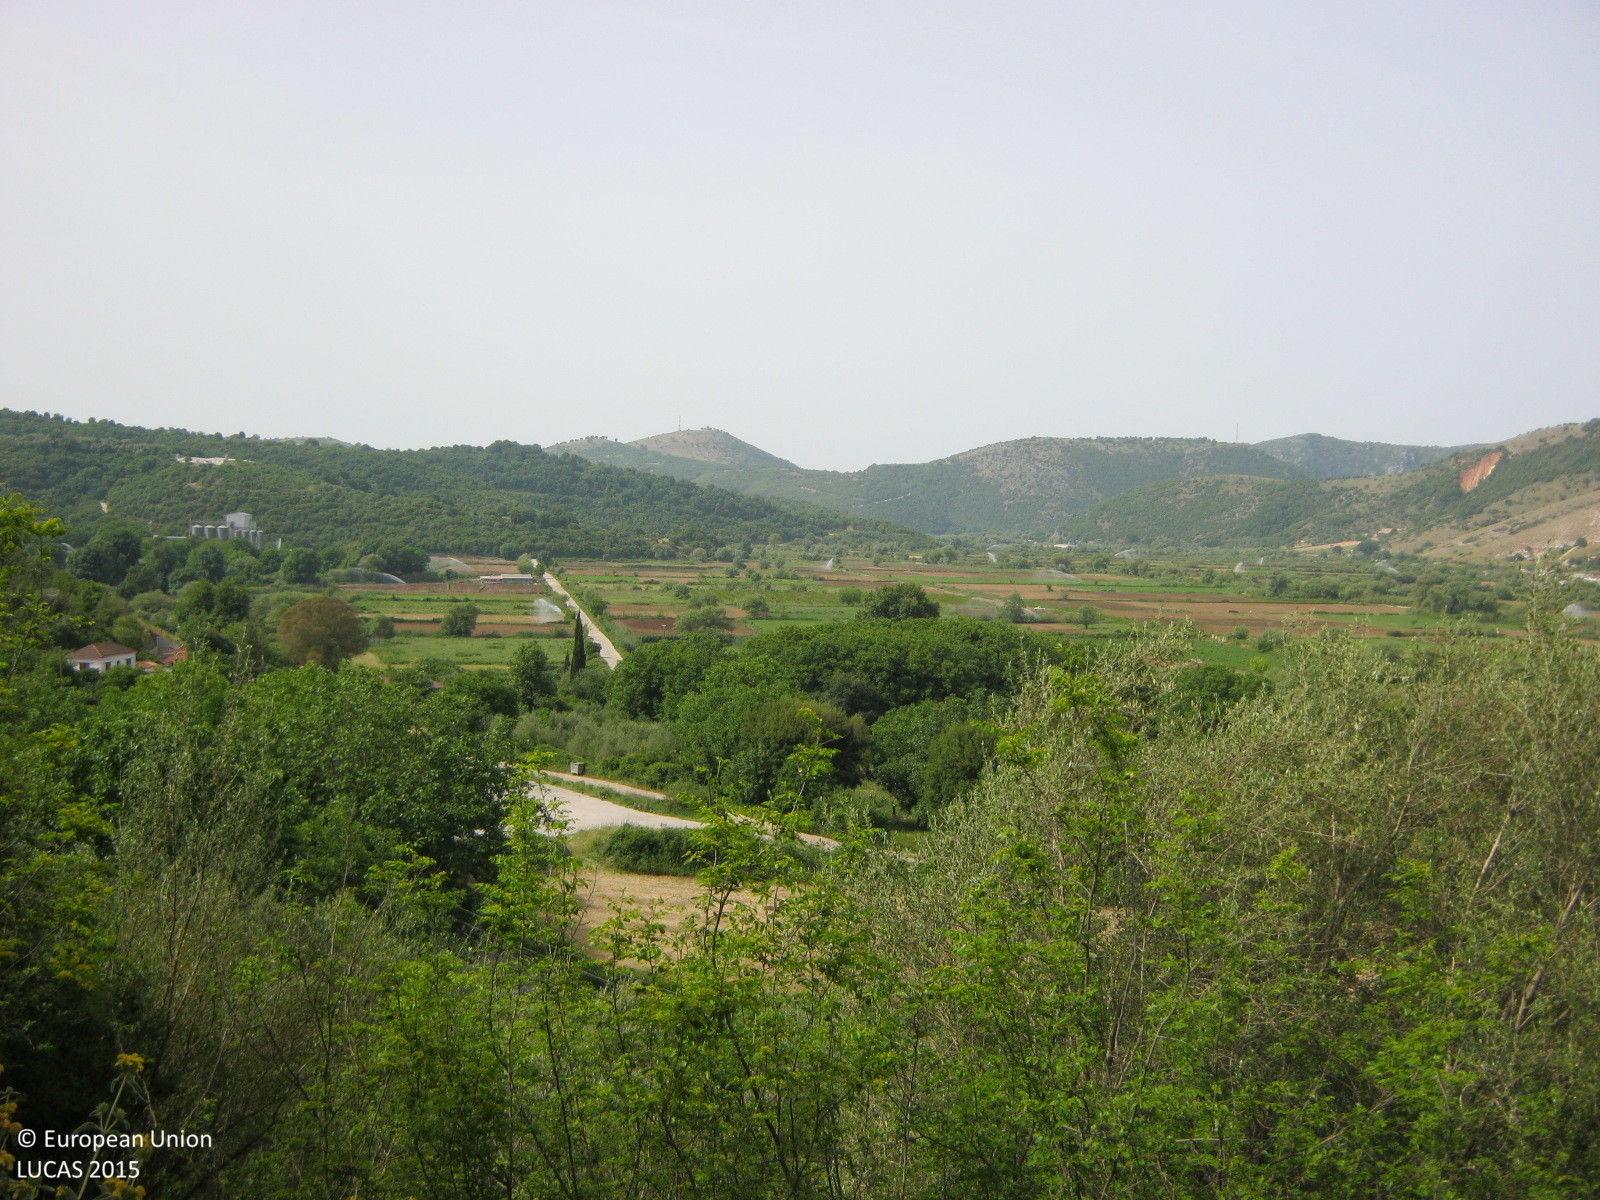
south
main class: Shrubland
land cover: Shrubland without tree cover
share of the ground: 50 - 75 %
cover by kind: shrubs 50 %, herbaceous plants 40 %, consolidated bare surface 10 %
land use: Agriculture (excluding fallow land and kitchen gardens)
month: May
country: GR
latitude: 39.3127
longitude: 20.8885
